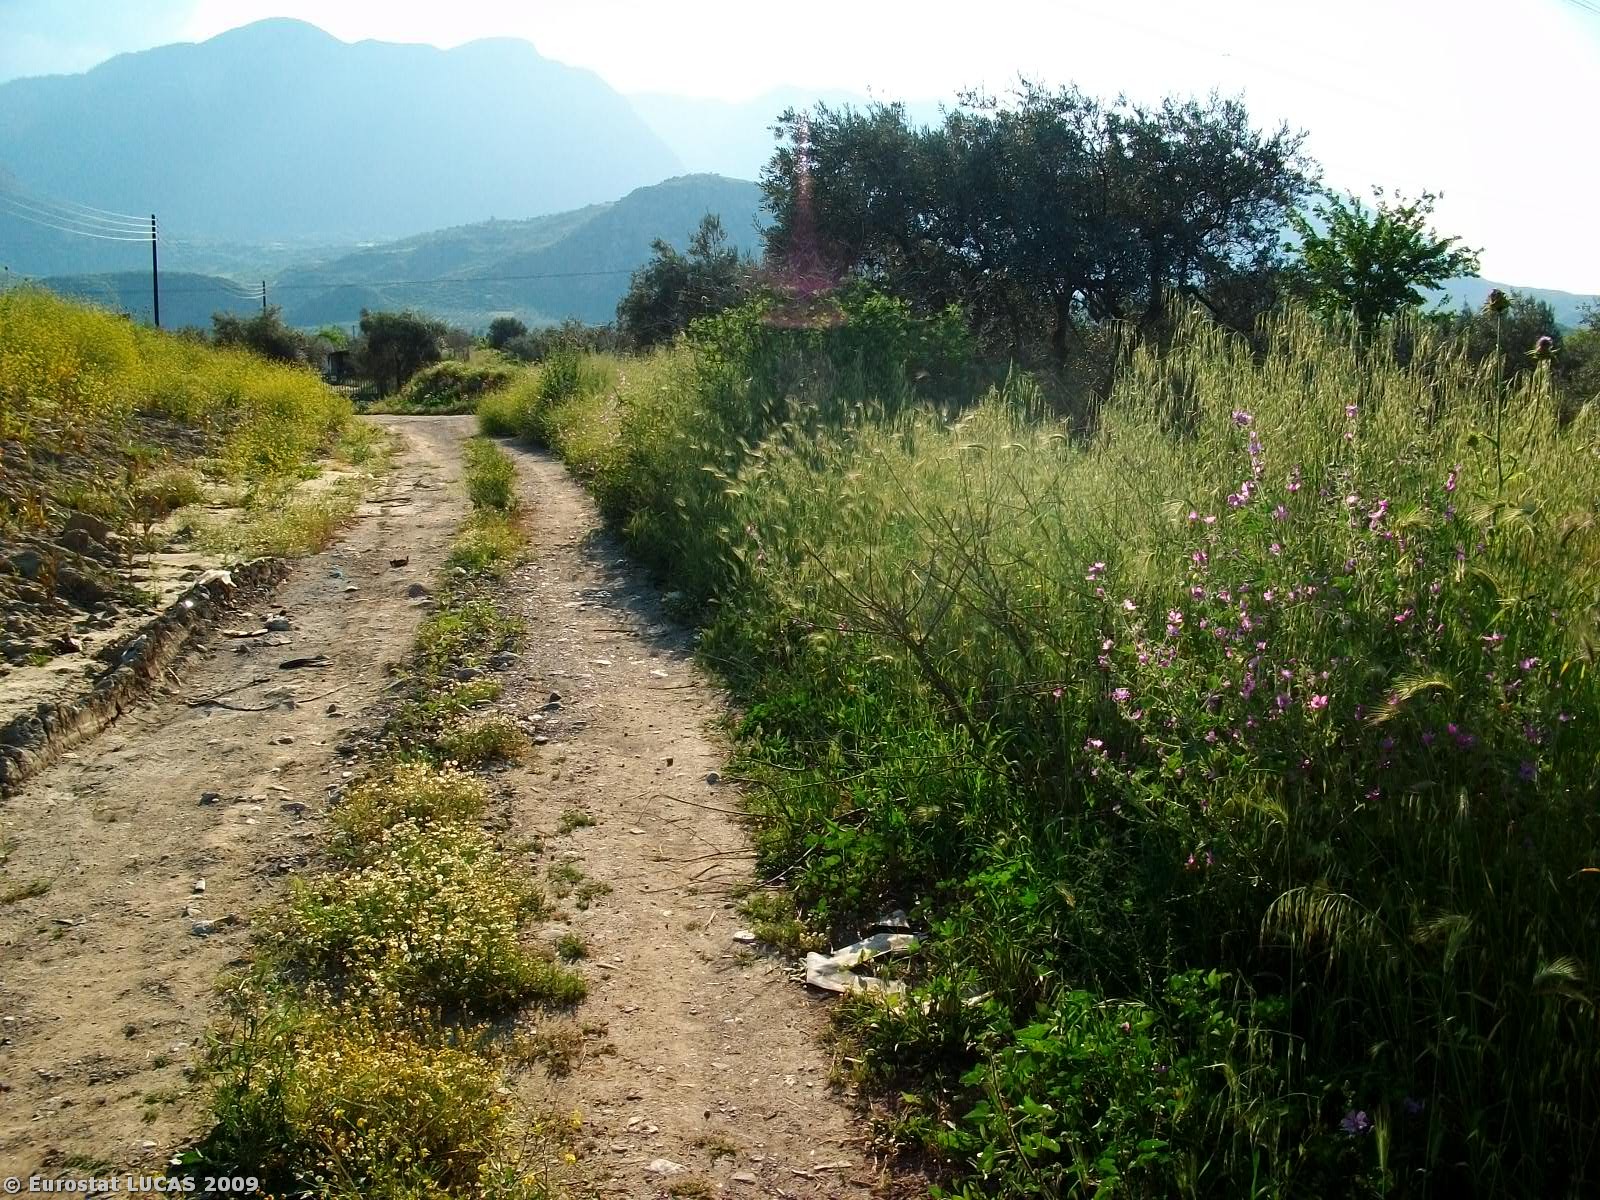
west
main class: Cropland
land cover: Olive groves
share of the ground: 50 - 75 %
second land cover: Grassland with sparse tree/shrub cover
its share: 50 - 75 %
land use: Agriculture (excluding fallow land and kitchen gardens)
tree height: < 5 m
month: May
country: GR
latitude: 38.8151
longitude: 22.4292
